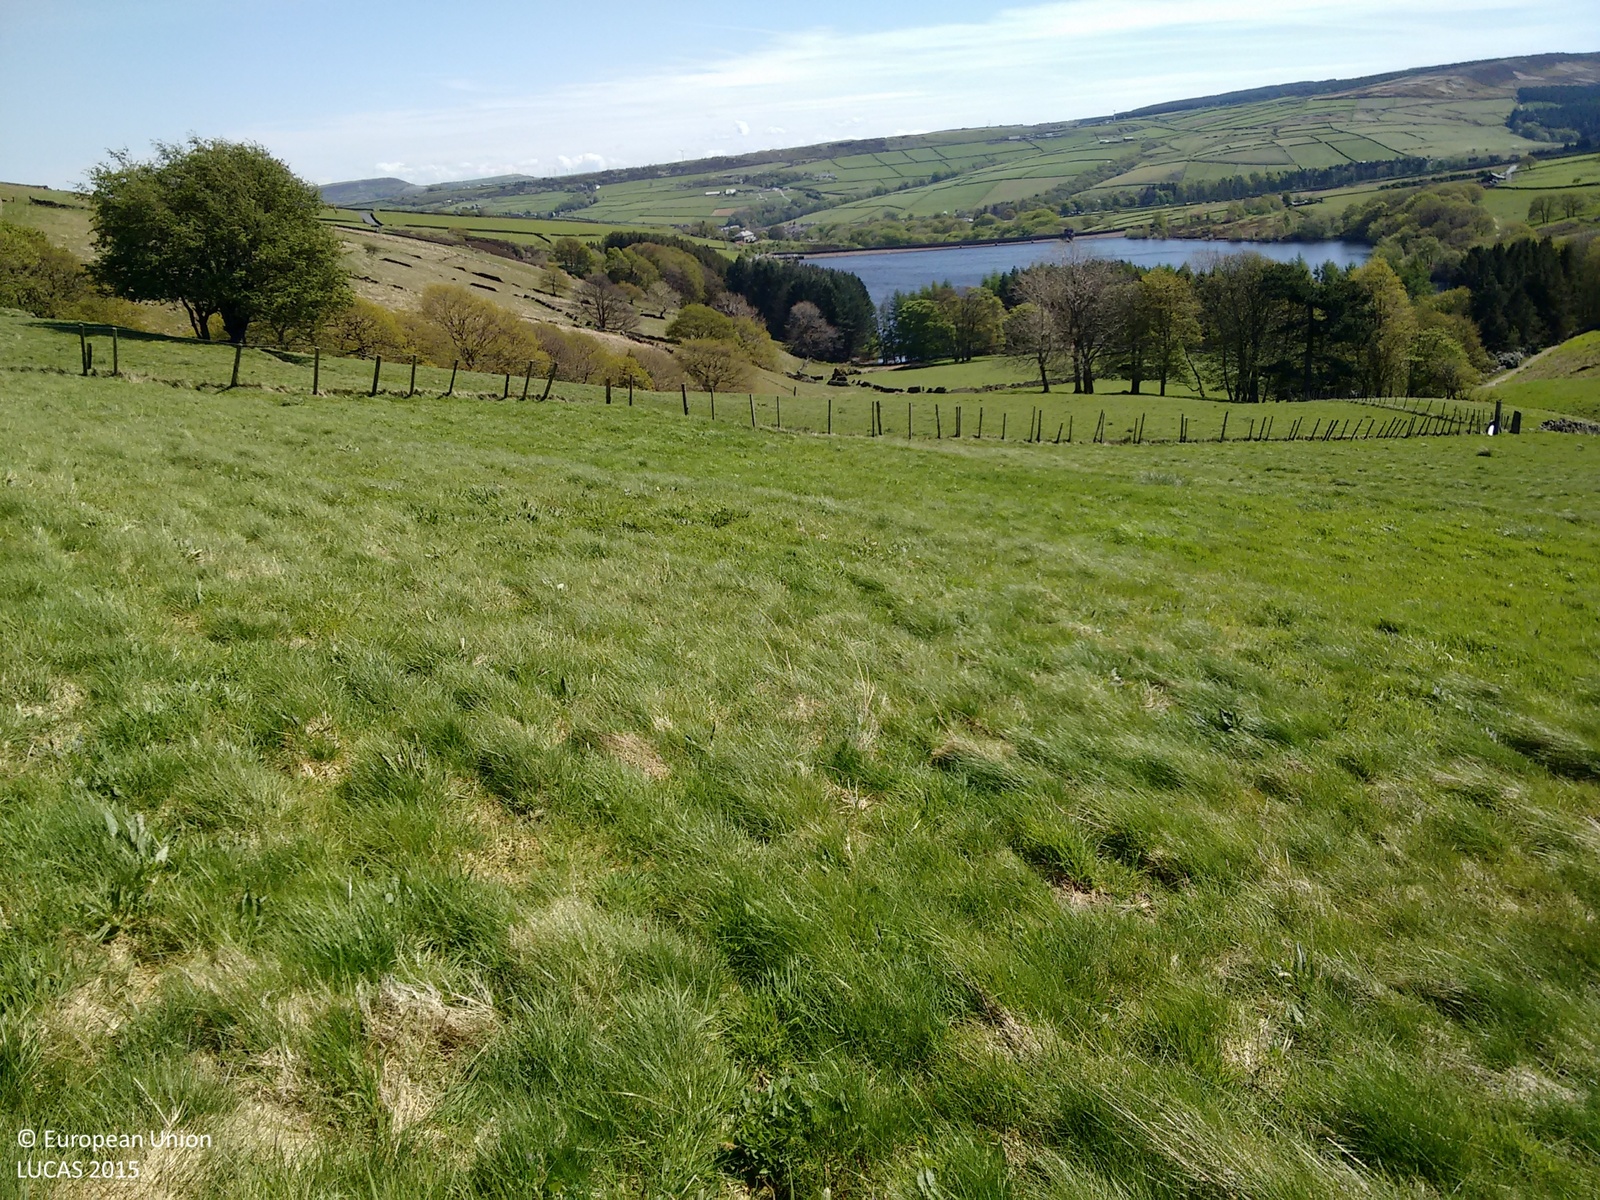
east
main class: Grassland
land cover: Grassland without tree/shrub cover
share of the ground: > 75 %
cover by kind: herbaceous plants 100 %
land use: Agriculture (excluding fallow land and kitchen gardens)
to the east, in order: Grassland without tree/shrub cover; Fences; Grassland without tree/shrub cover; Dry stone walls; Grassland without tree/shrub cover; Fences; Grassland without tree/shrub cover; Fences; Broadleaved woodland; Grassland without tree/shrub cover; Fences; Grassland without tree/shrub cover
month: May
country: GB
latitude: 53.5634
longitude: -1.8466
